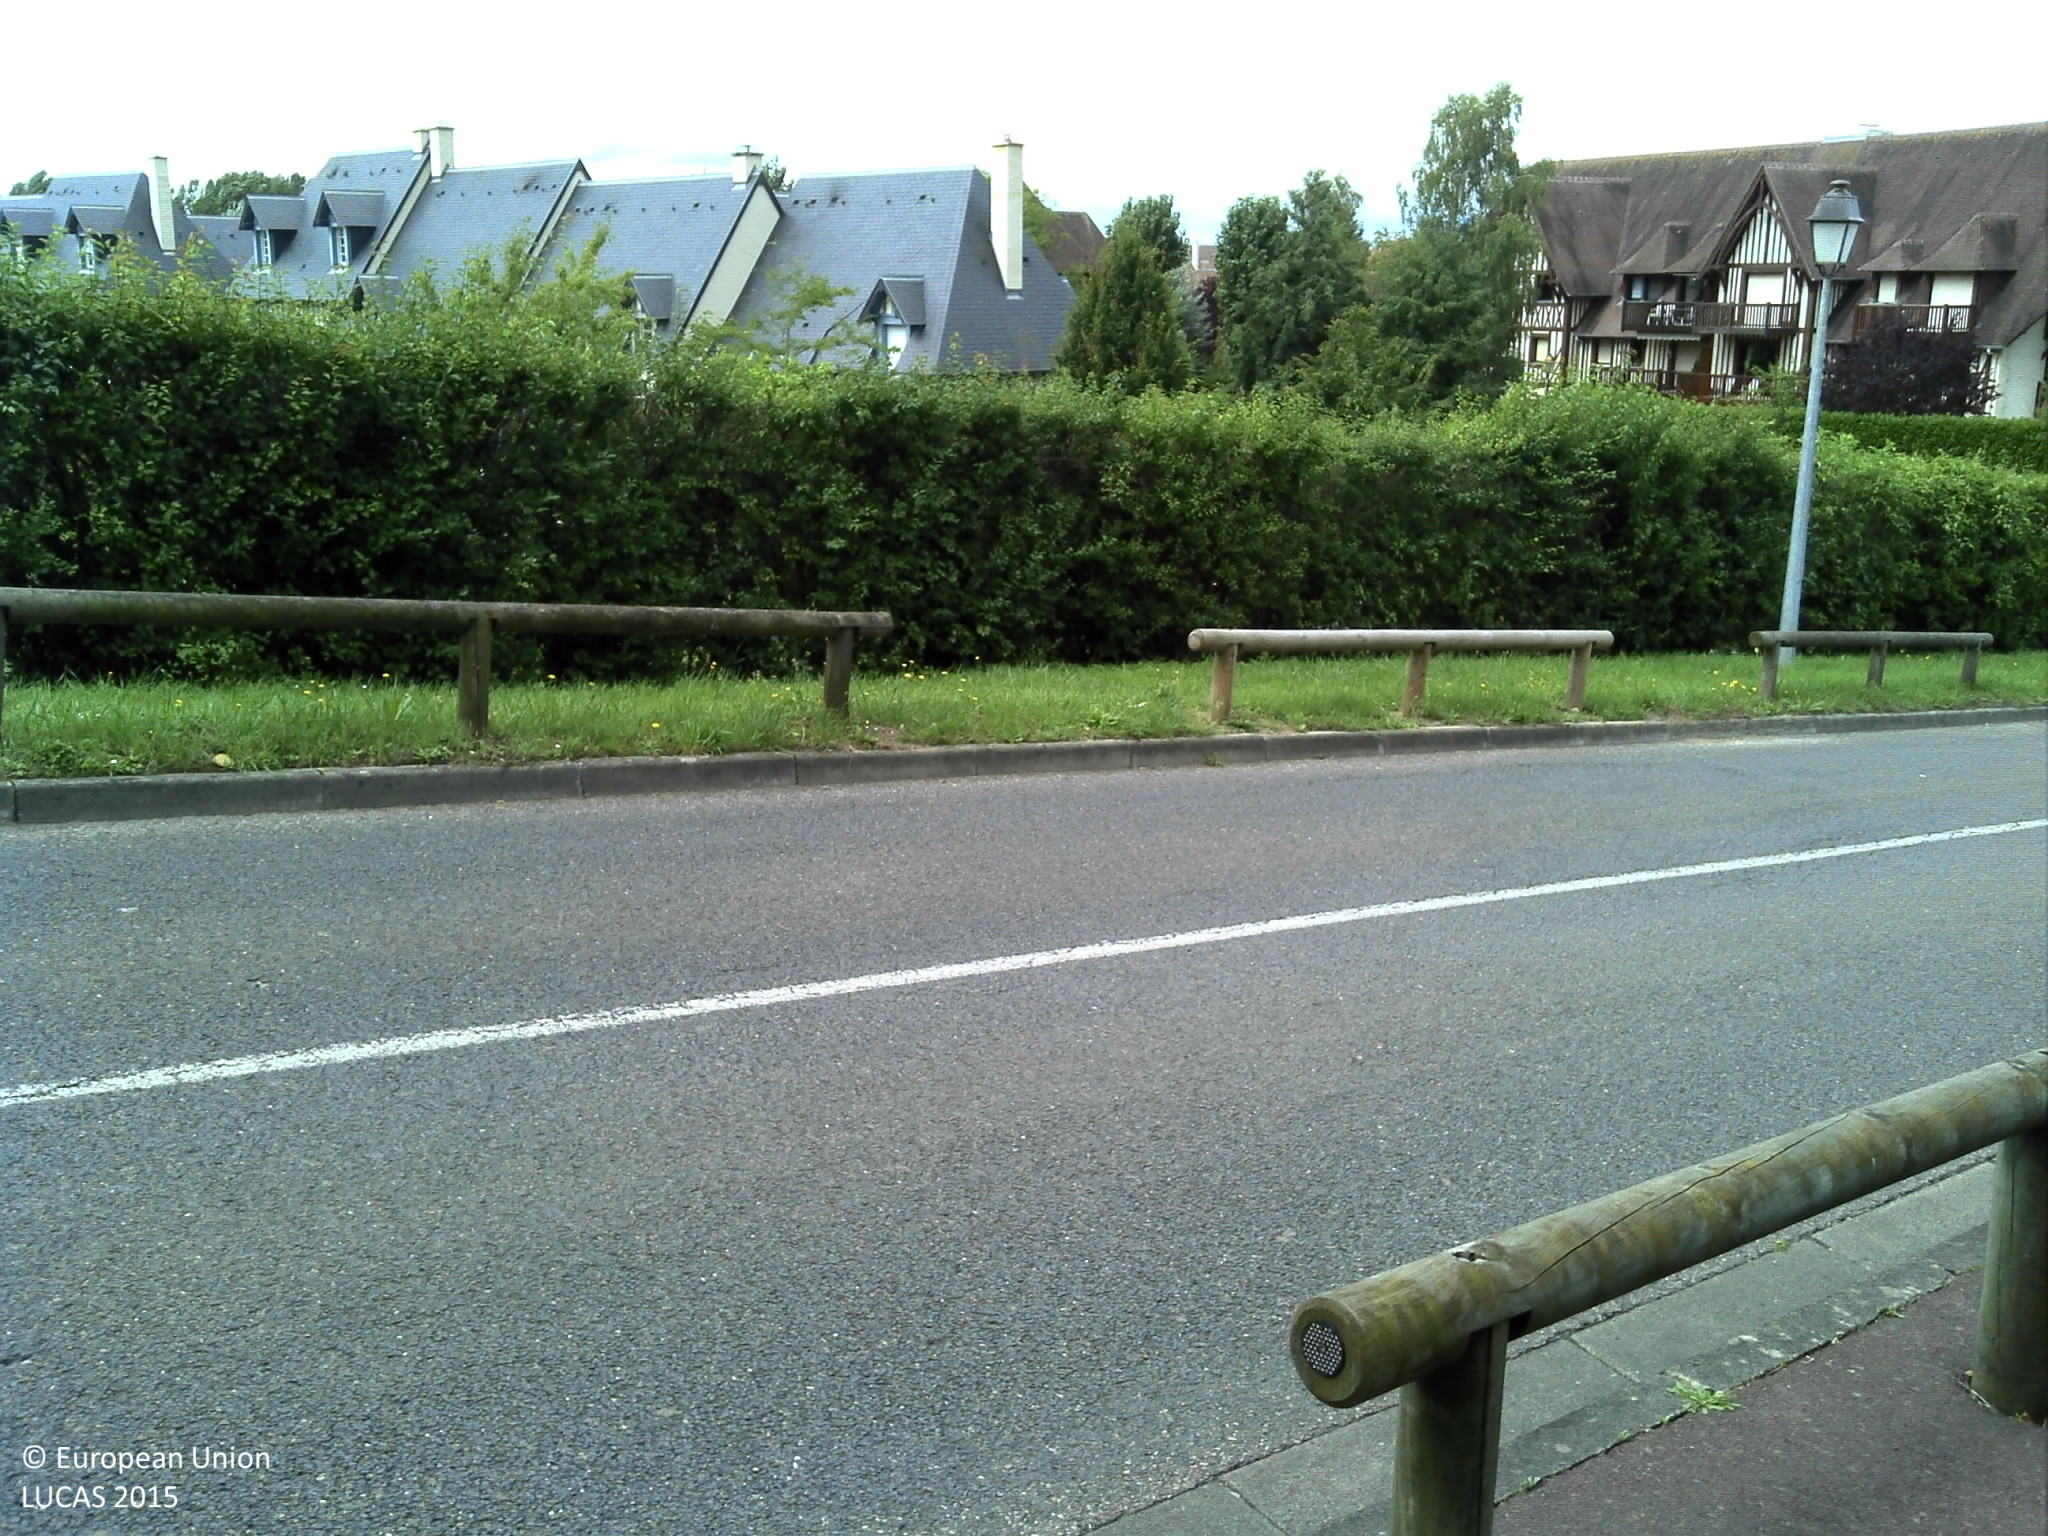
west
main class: Grassland
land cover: Grassland without tree/shrub cover
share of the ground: > 75 %
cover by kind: herbaceous plants 100 %
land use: Sport
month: August
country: FR
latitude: 49.3512
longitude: 0.0715
